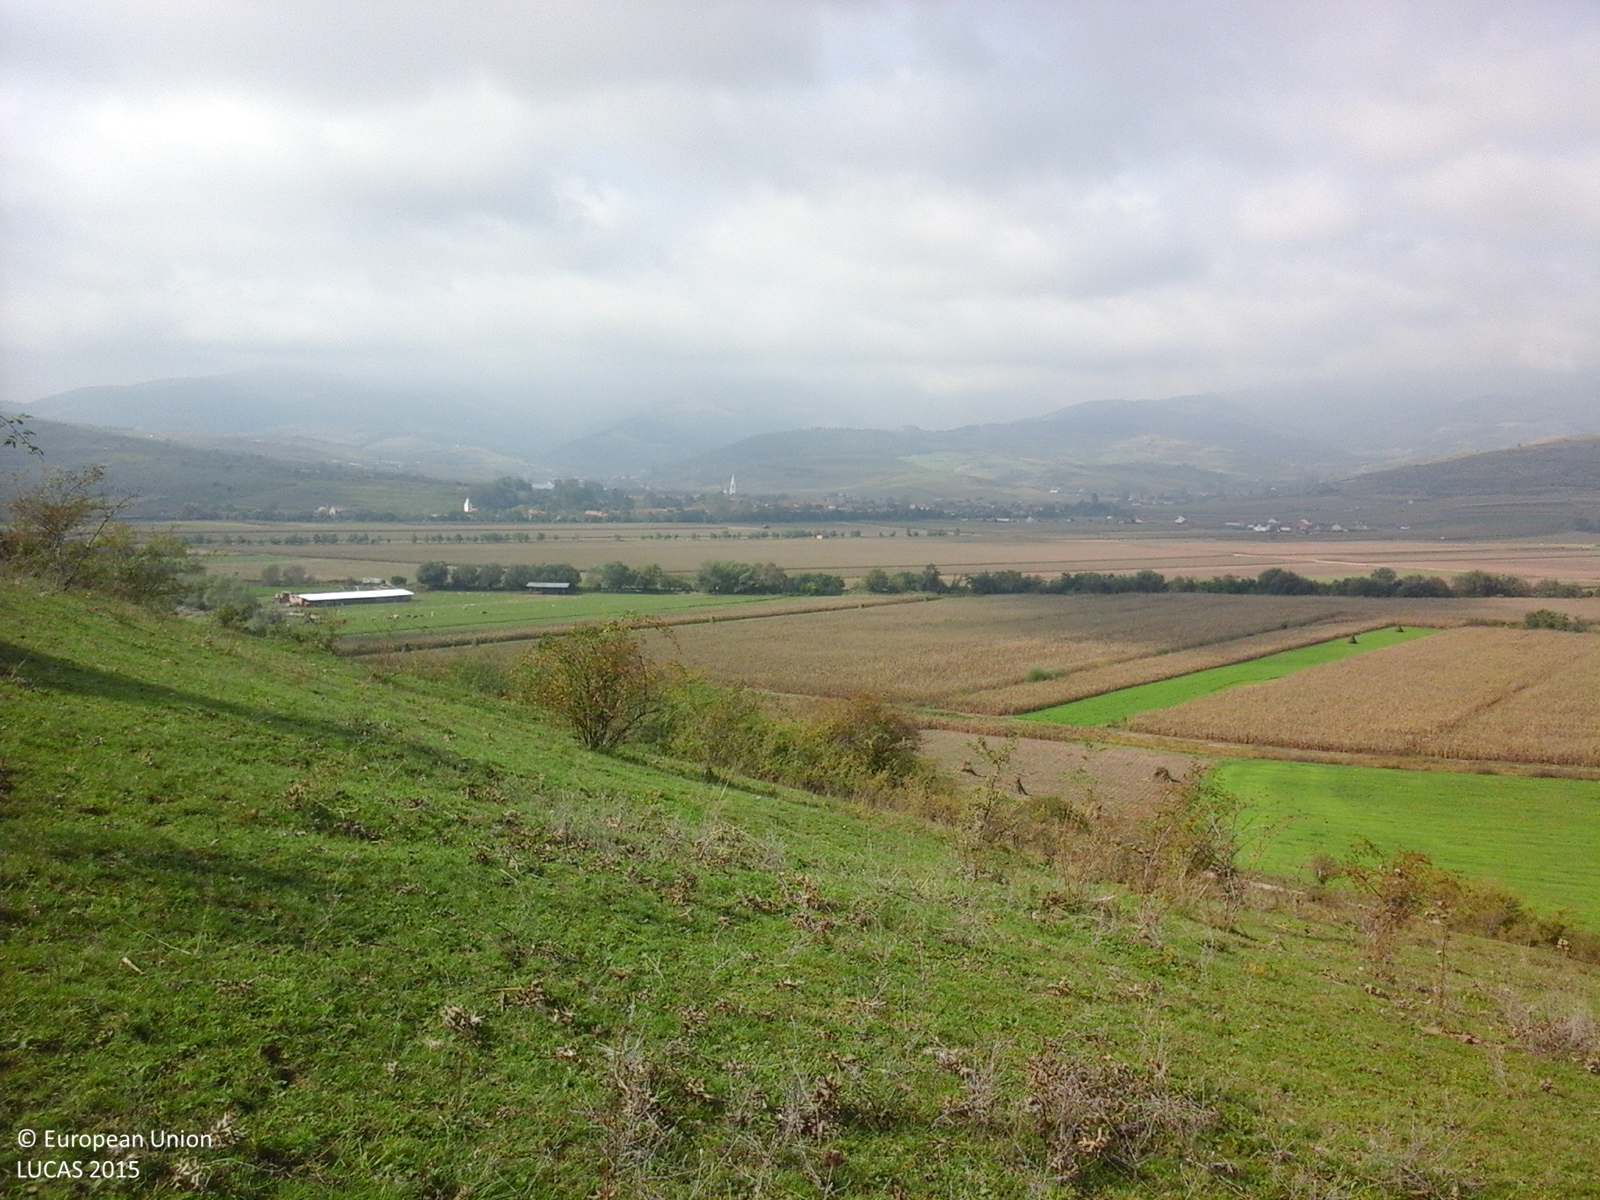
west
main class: Grassland
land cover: Grassland with sparse tree/shrub cover
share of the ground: > 75 %
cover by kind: herbaceous plants 85 %, shrubs 10 %, broadleaved forest trees 5 %
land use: Agriculture (excluding fallow land and kitchen gardens)
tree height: > 5 m
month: October
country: RO
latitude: 46.1423
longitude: 23.5426
